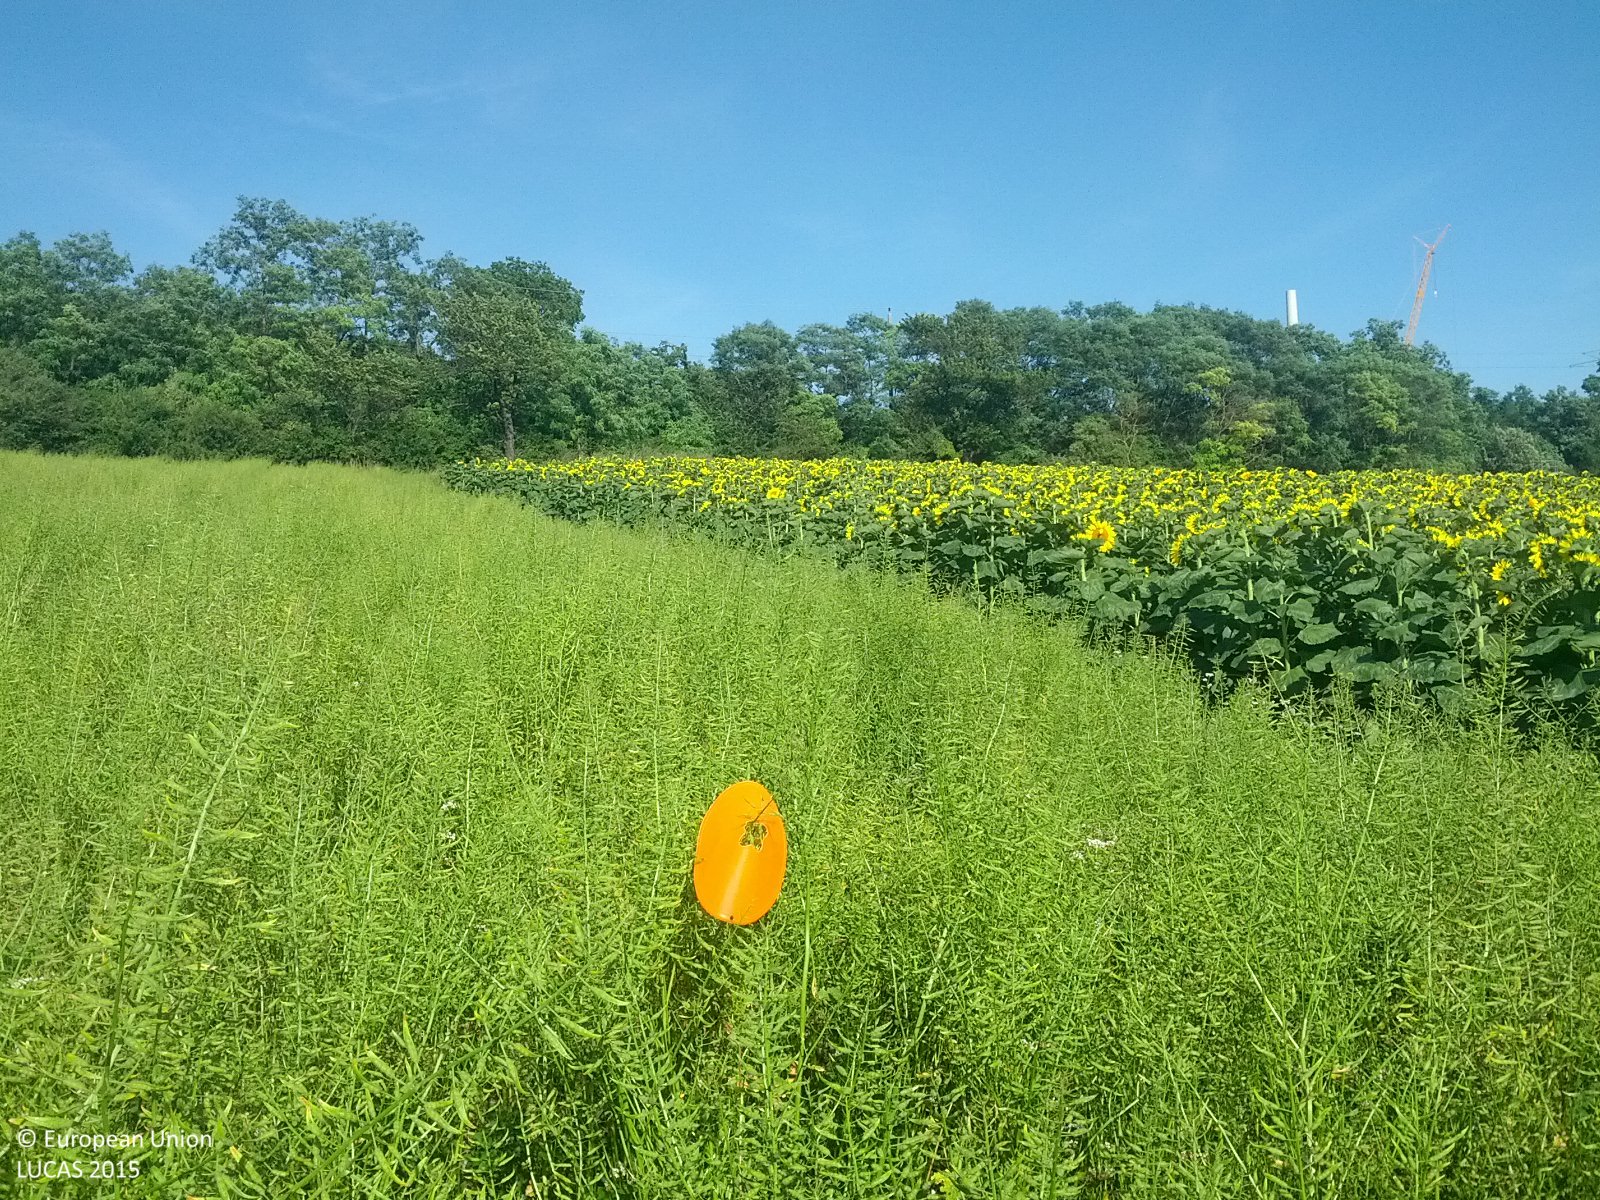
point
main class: Cropland
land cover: Other fibre and oleaginous crops
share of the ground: > 75 %
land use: Agriculture (excluding fallow land and kitchen gardens)
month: July
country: AT
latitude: 48.5196
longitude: 16.4912
